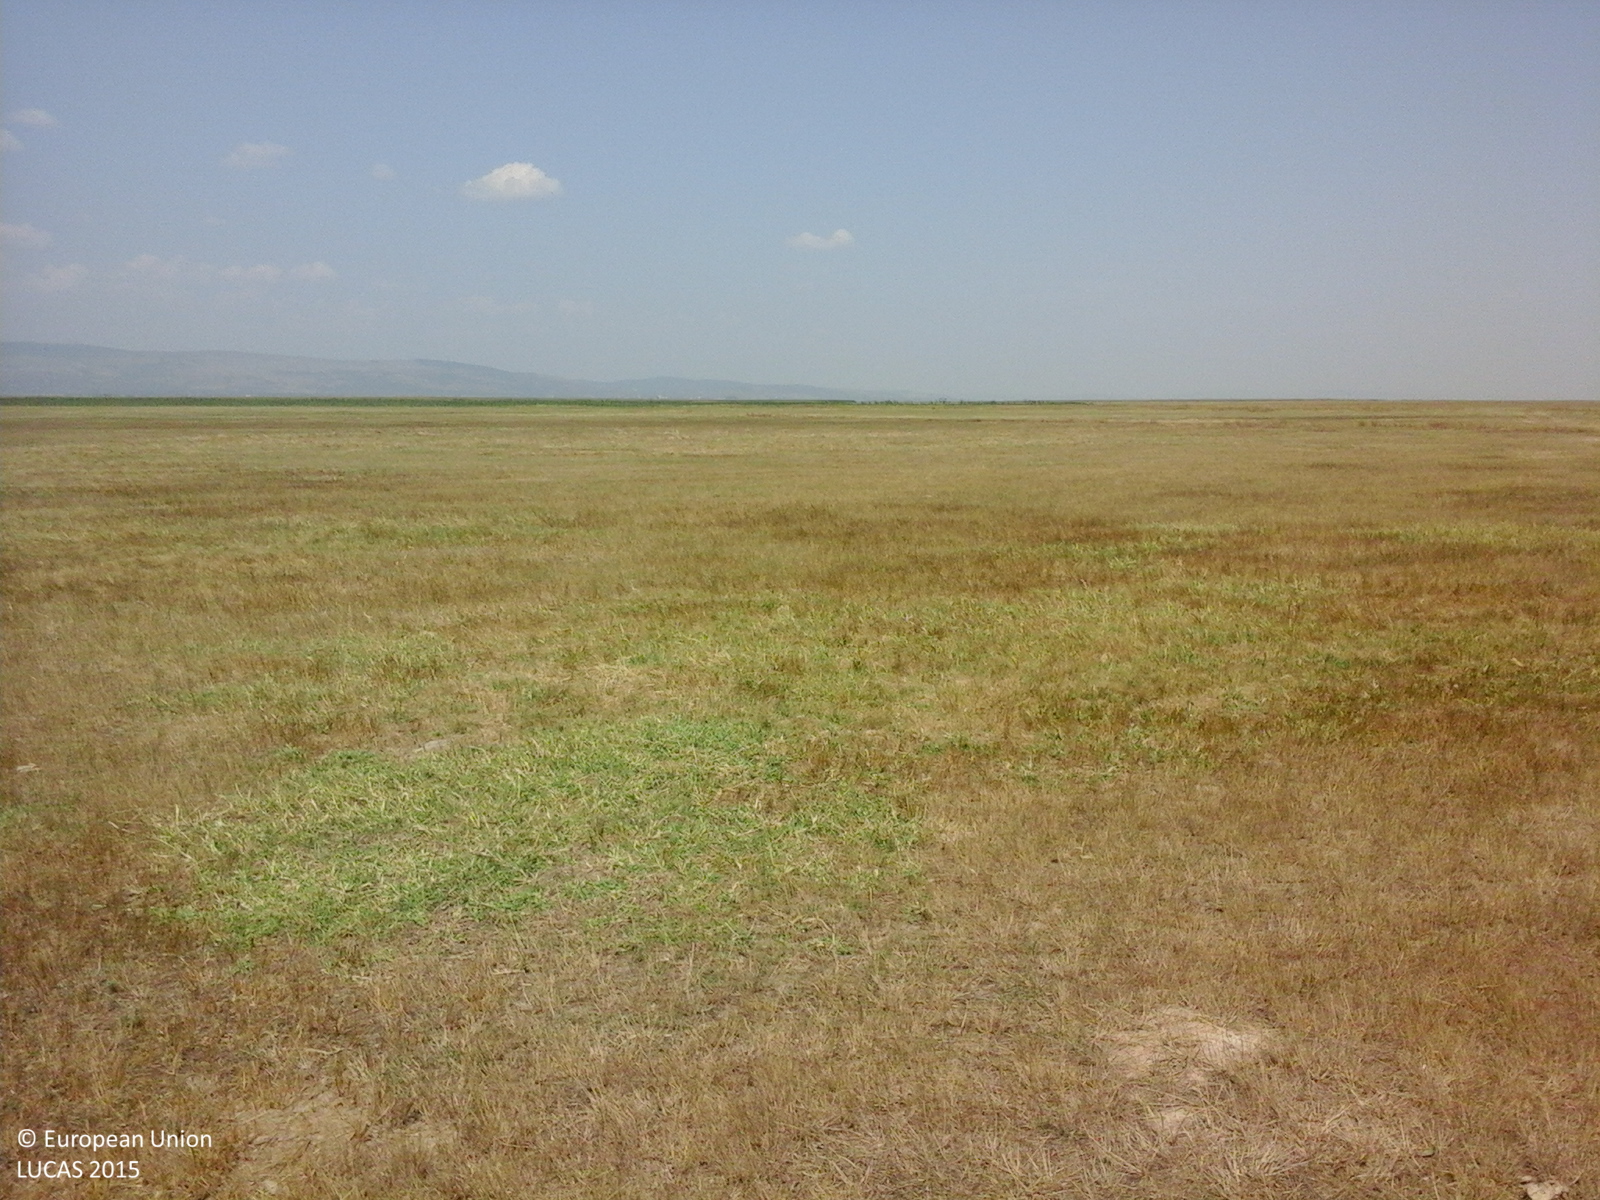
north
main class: Grassland
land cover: Grassland without tree/shrub cover
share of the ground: > 75 %
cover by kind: herbaceous plants 100 %
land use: Agriculture (excluding fallow land and kitchen gardens)
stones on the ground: < 10 %
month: August
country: RO
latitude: 44.9971
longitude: 26.6536
